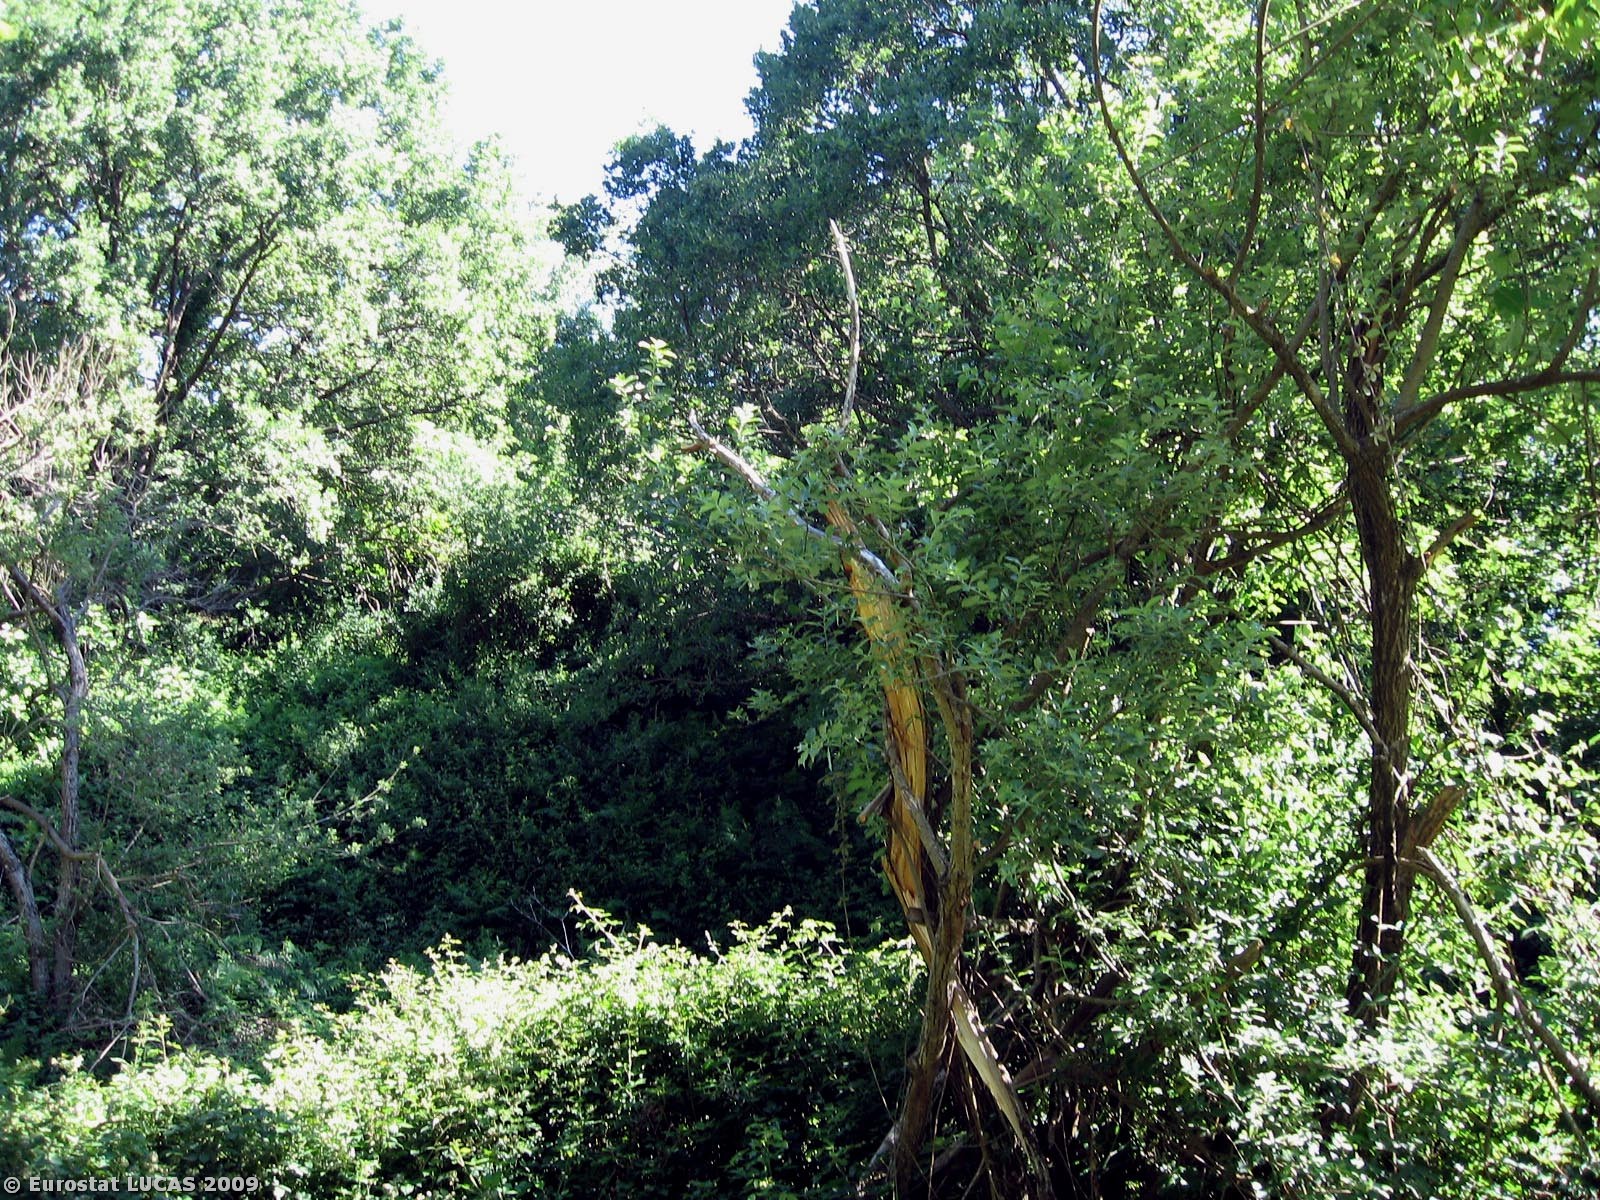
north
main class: Woodland
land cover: Broadleaved woodland
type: thermophilous deciduous forest
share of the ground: 50 - 75 %
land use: Forestry
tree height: > 5 m
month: June
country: IT
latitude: 38.6964
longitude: 16.3924
